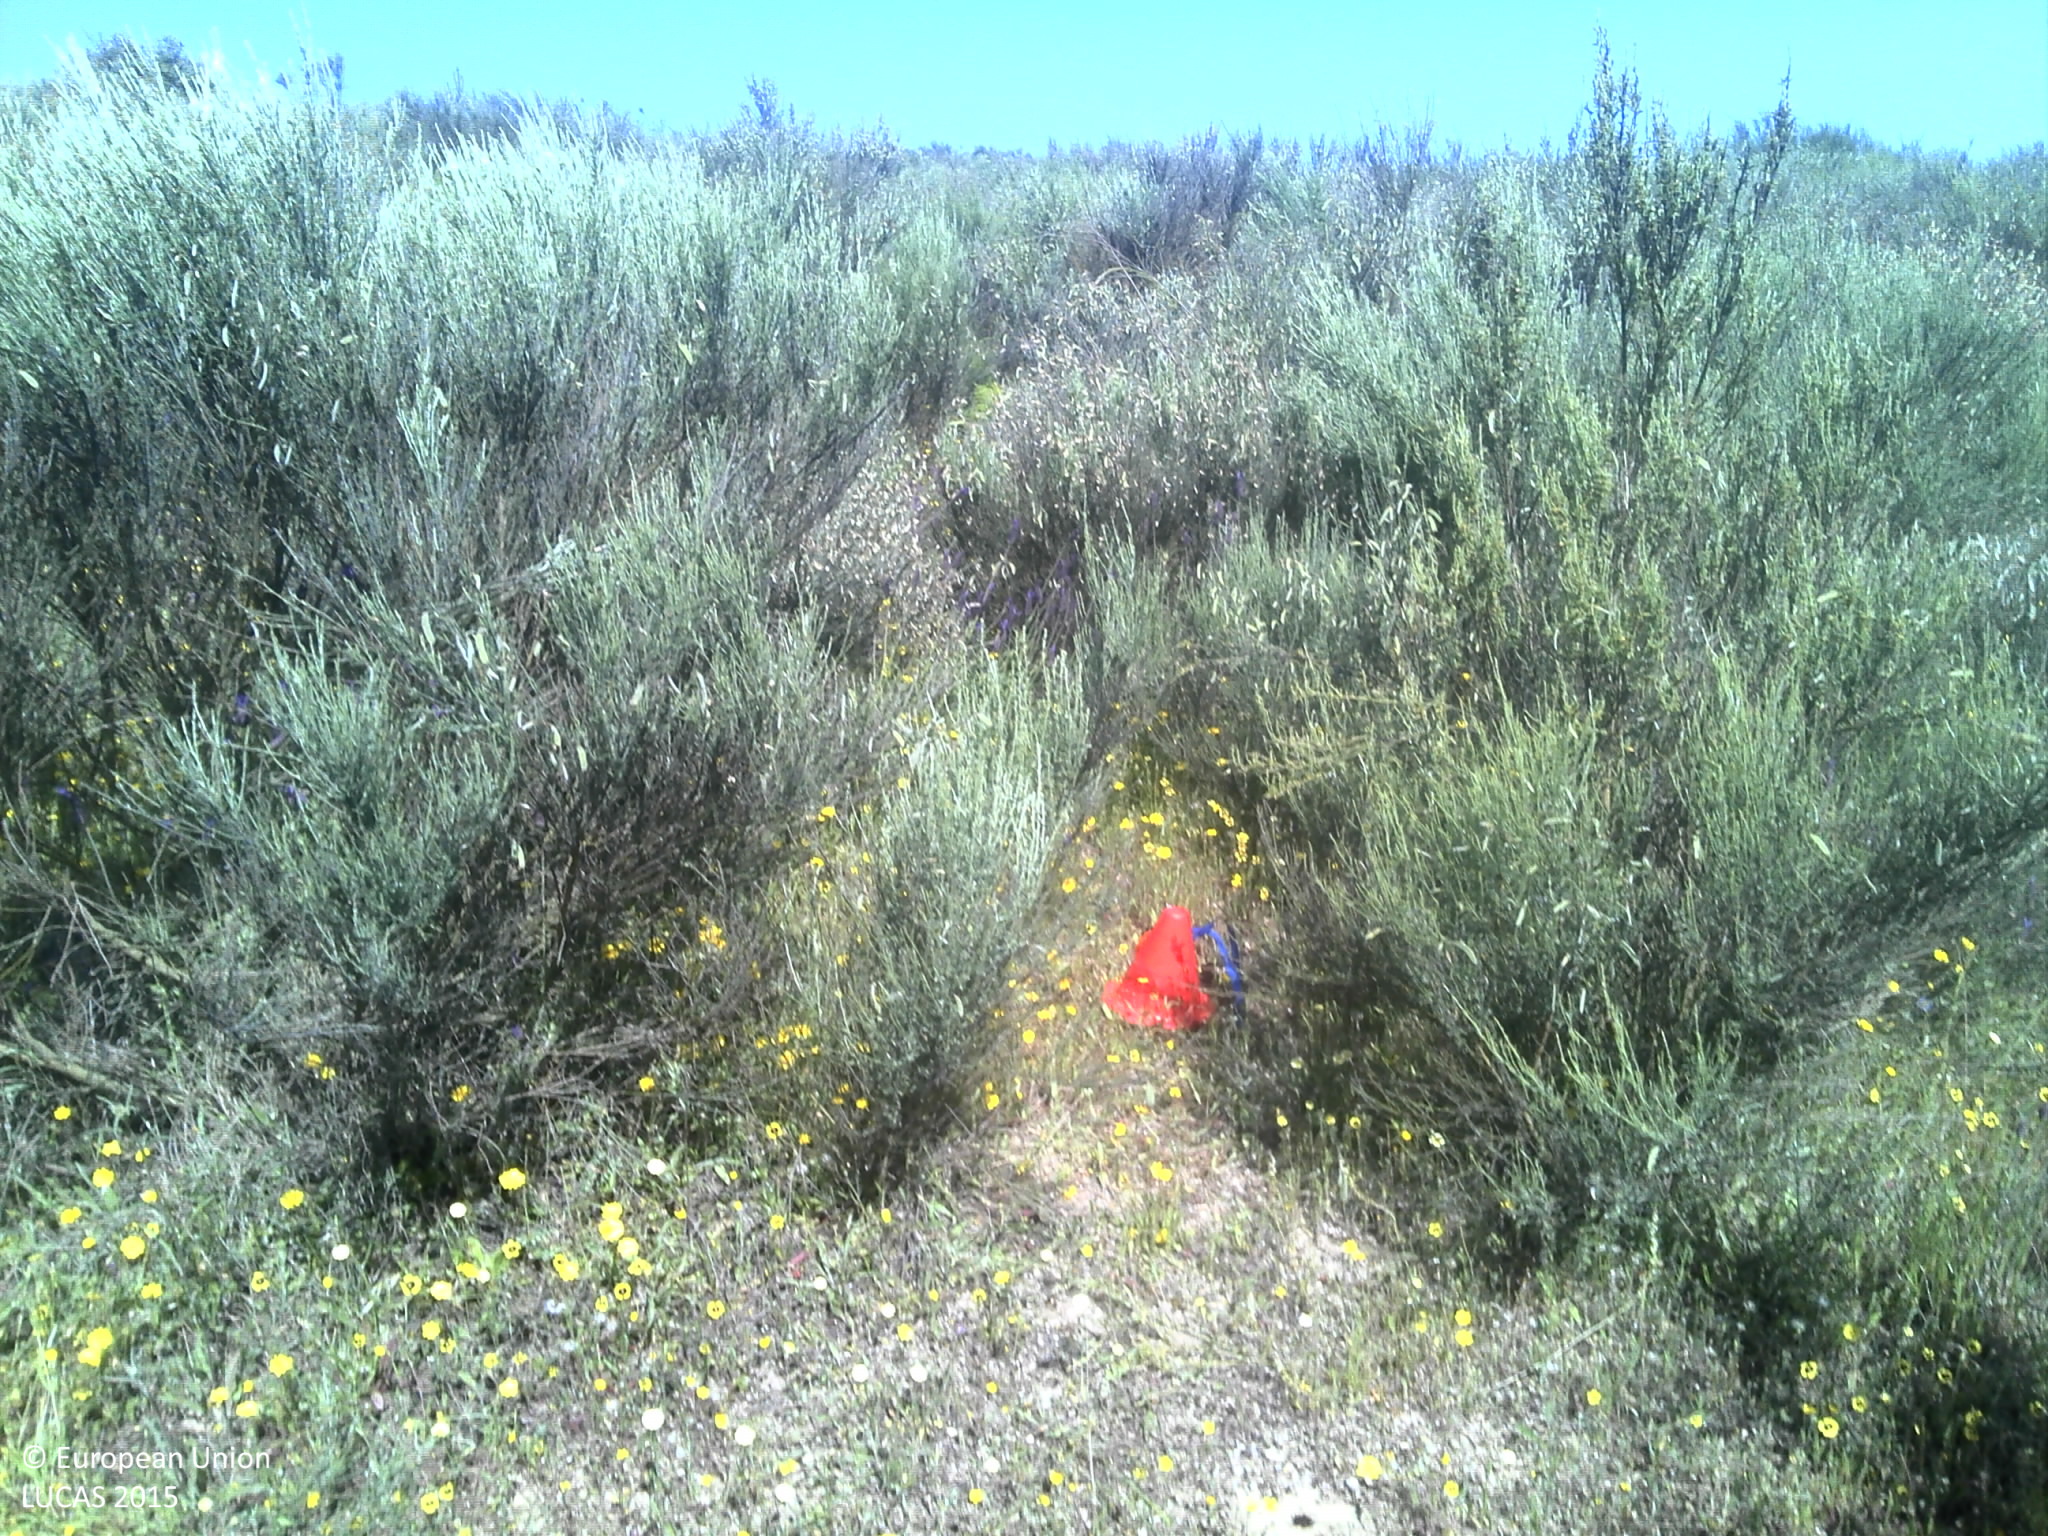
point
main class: Shrubland
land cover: Shrubland without tree cover
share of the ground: 50 - 75 %
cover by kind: shrubs 70 %, herbaceous plants 20 %, unconsolidated bare surface 10 %
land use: Abandoned areas
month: May
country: PT
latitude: 40.6947
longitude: -7.2799
